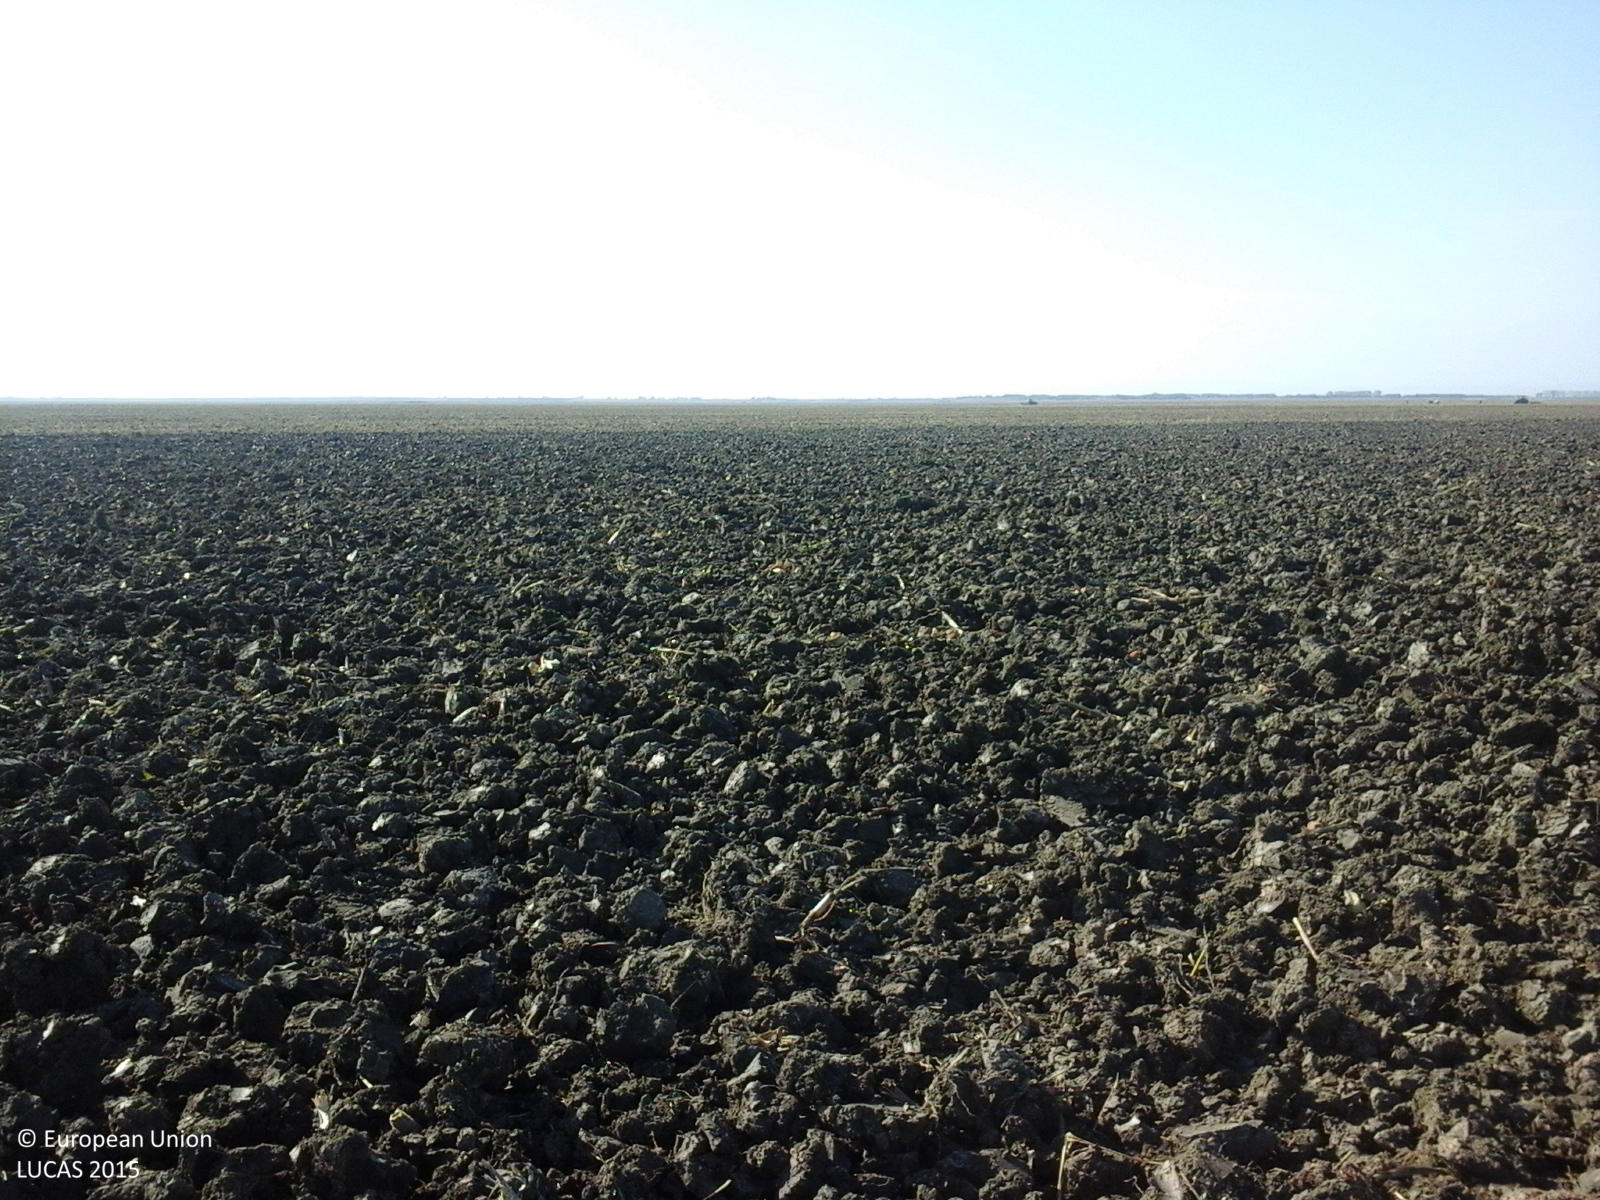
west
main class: Cropland
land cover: Maize
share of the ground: < 10 %
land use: Agriculture (excluding fallow land and kitchen gardens)
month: October
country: RO
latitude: 45.4277
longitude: 27.3916
